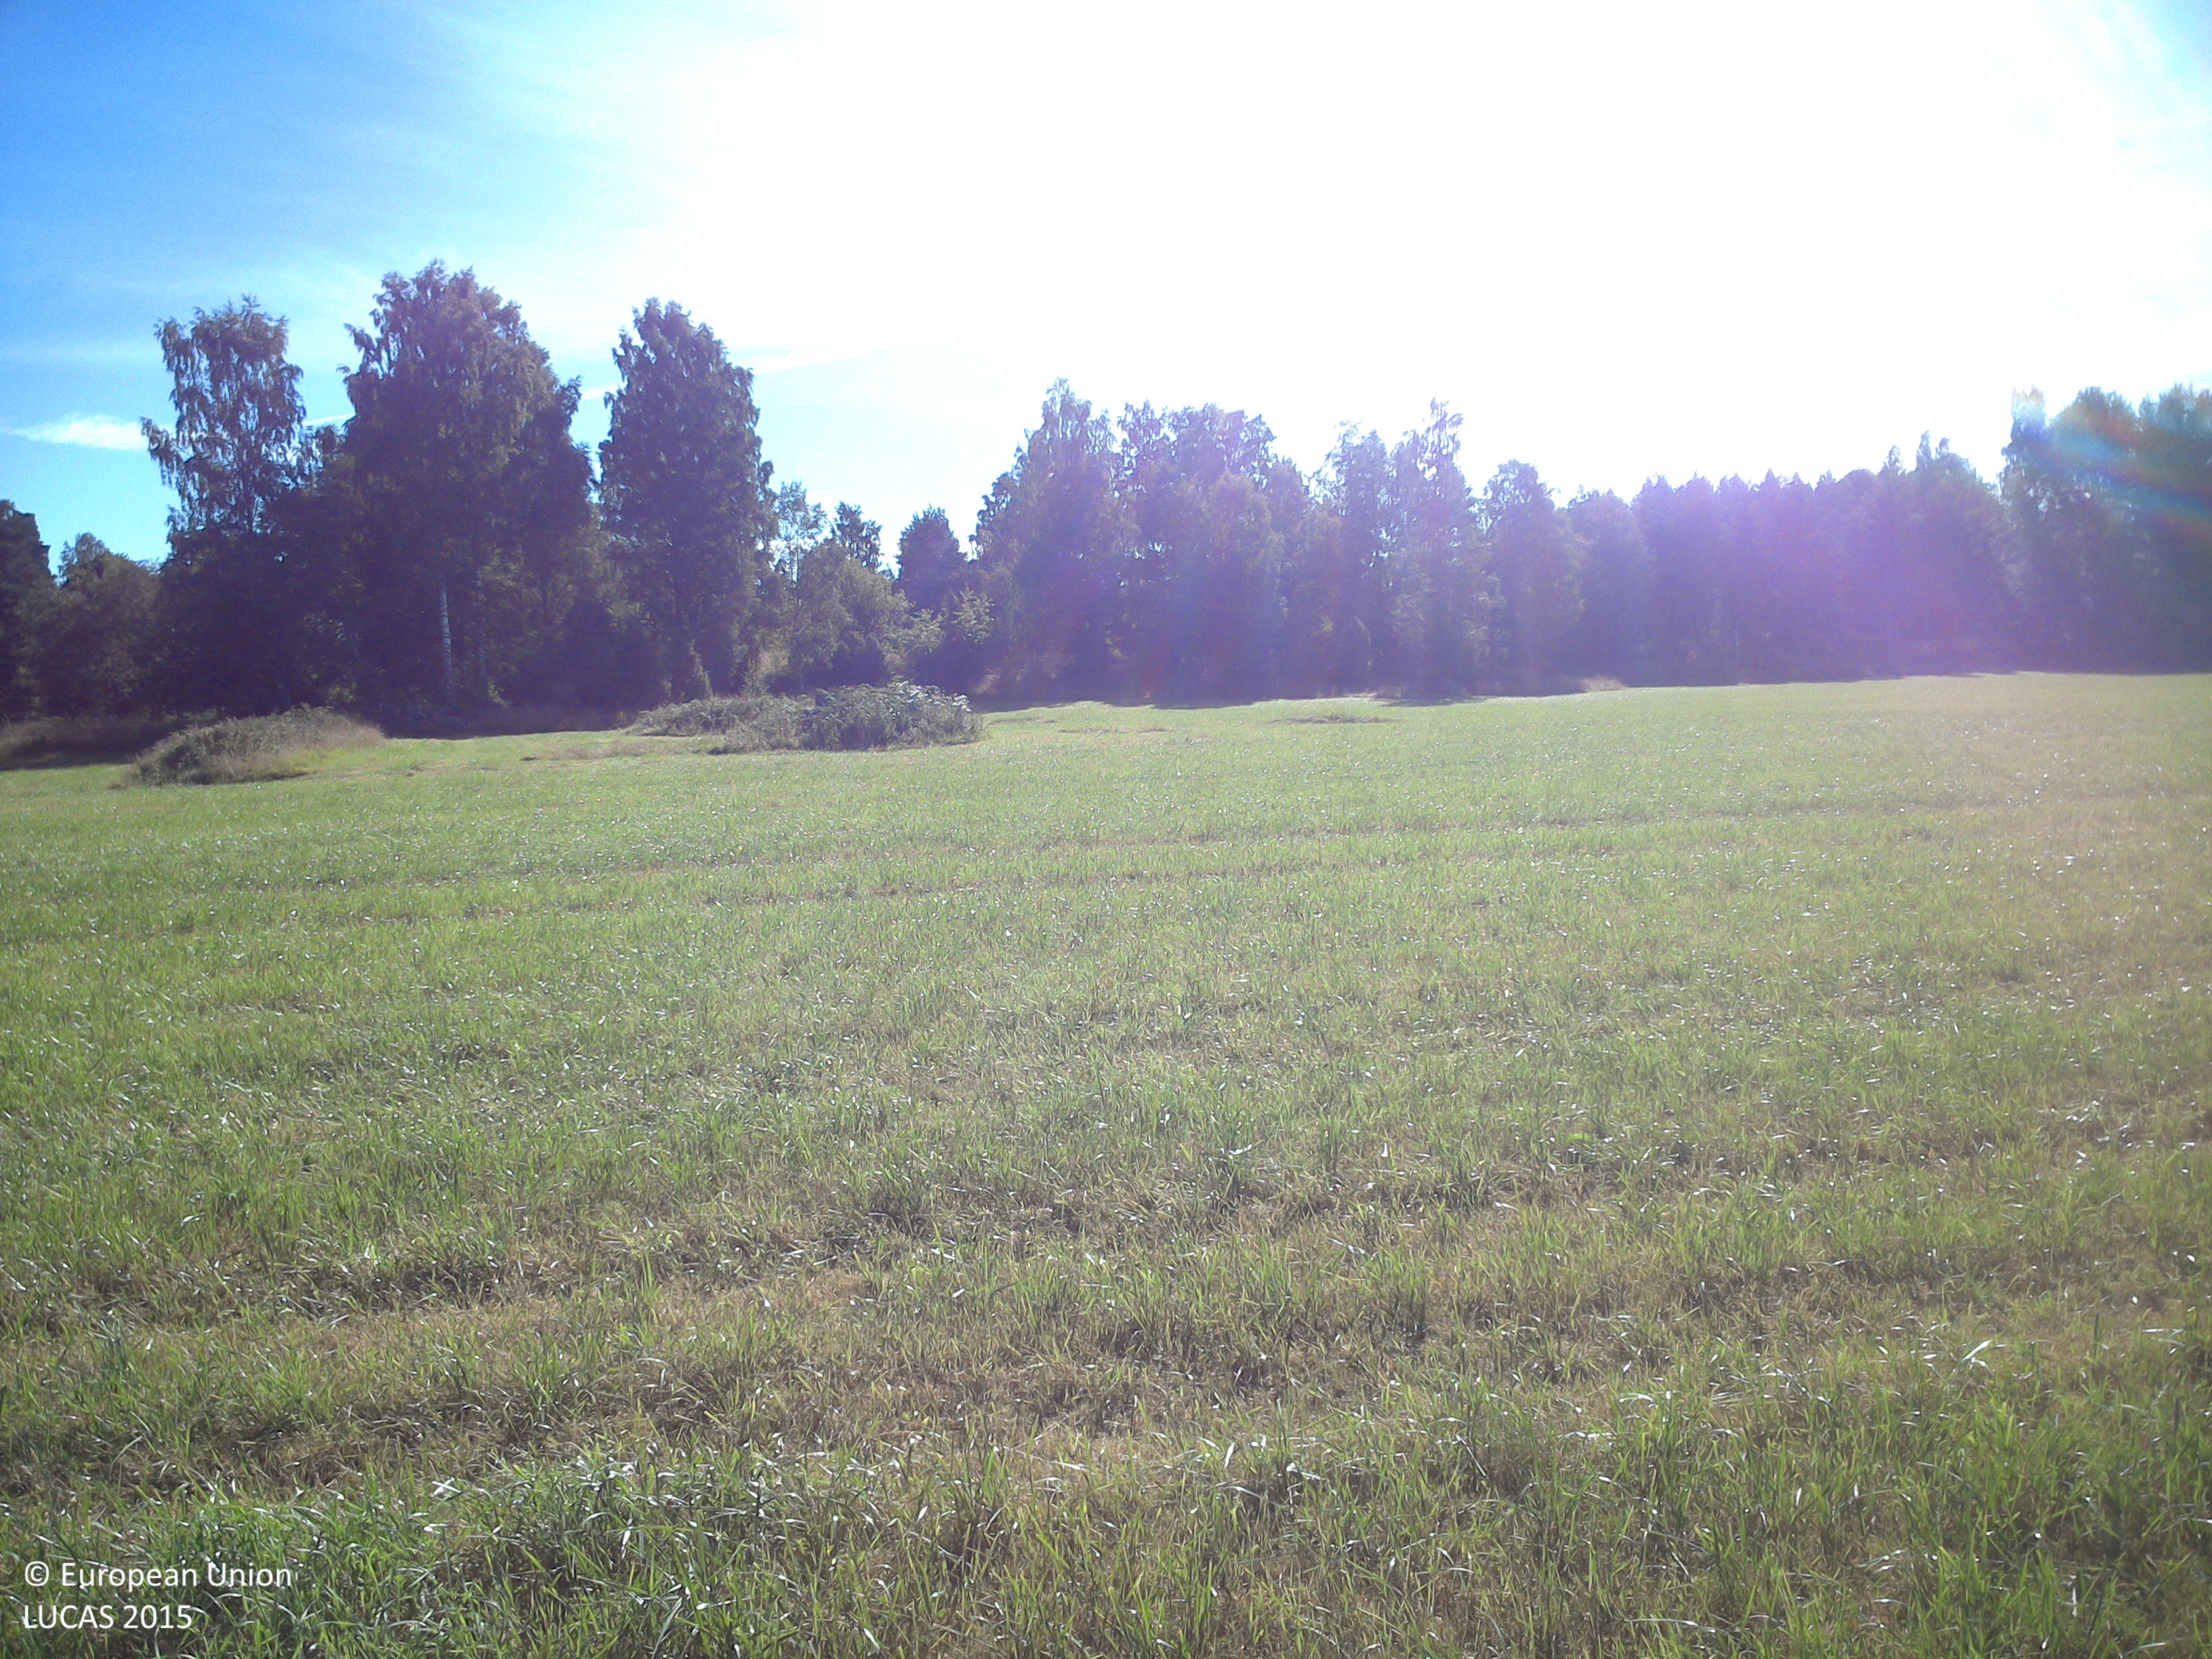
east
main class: Cropland
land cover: Other leguminous and mixtures for fodder
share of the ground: > 75 %
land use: Agriculture (excluding fallow land and kitchen gardens)
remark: Harvested field
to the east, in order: Other leguminous and mixtures for fodder; Broadleaved woodland; Grassland without tree/shrub cover; Grassland with sparse tree/shrub cover; Grassland without tree/shrub cover; Paved roads, cycling and walking lanes; Grass margins; Grassland with sparse tree/shrub cover; Broadleaved woodland; Grassland without tree/shrub cover
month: August
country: SE
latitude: 58.2545
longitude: 14.9530
